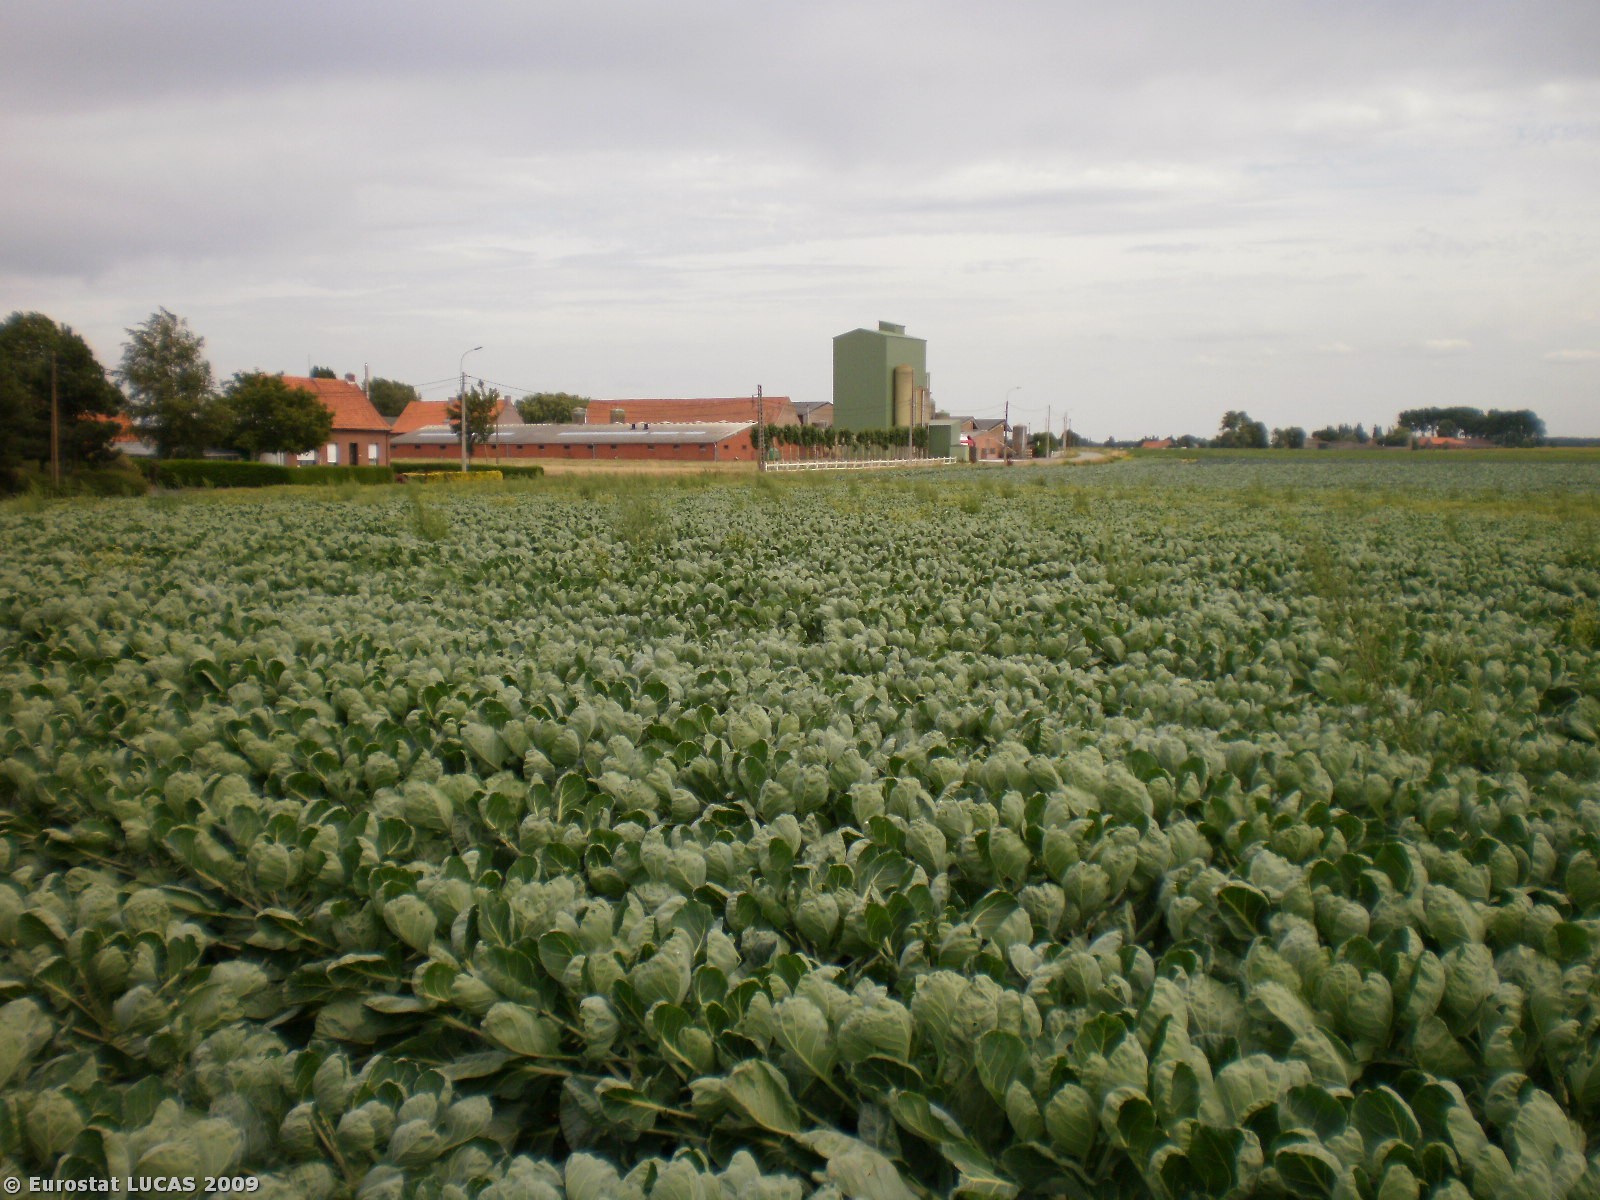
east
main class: Cropland
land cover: Other fresh vegetables
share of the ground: > 75 %
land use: Agriculture (excluding fallow land and kitchen gardens)
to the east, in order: Other fresh vegetables; Grass margins; Ditches and canals; Grass margins; Paved roads, cycling and walking lanes; Grass margins; Electric lines; Fences; Grassland without tree/shrub cover
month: July
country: BE
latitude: 50.8422
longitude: 2.8172
